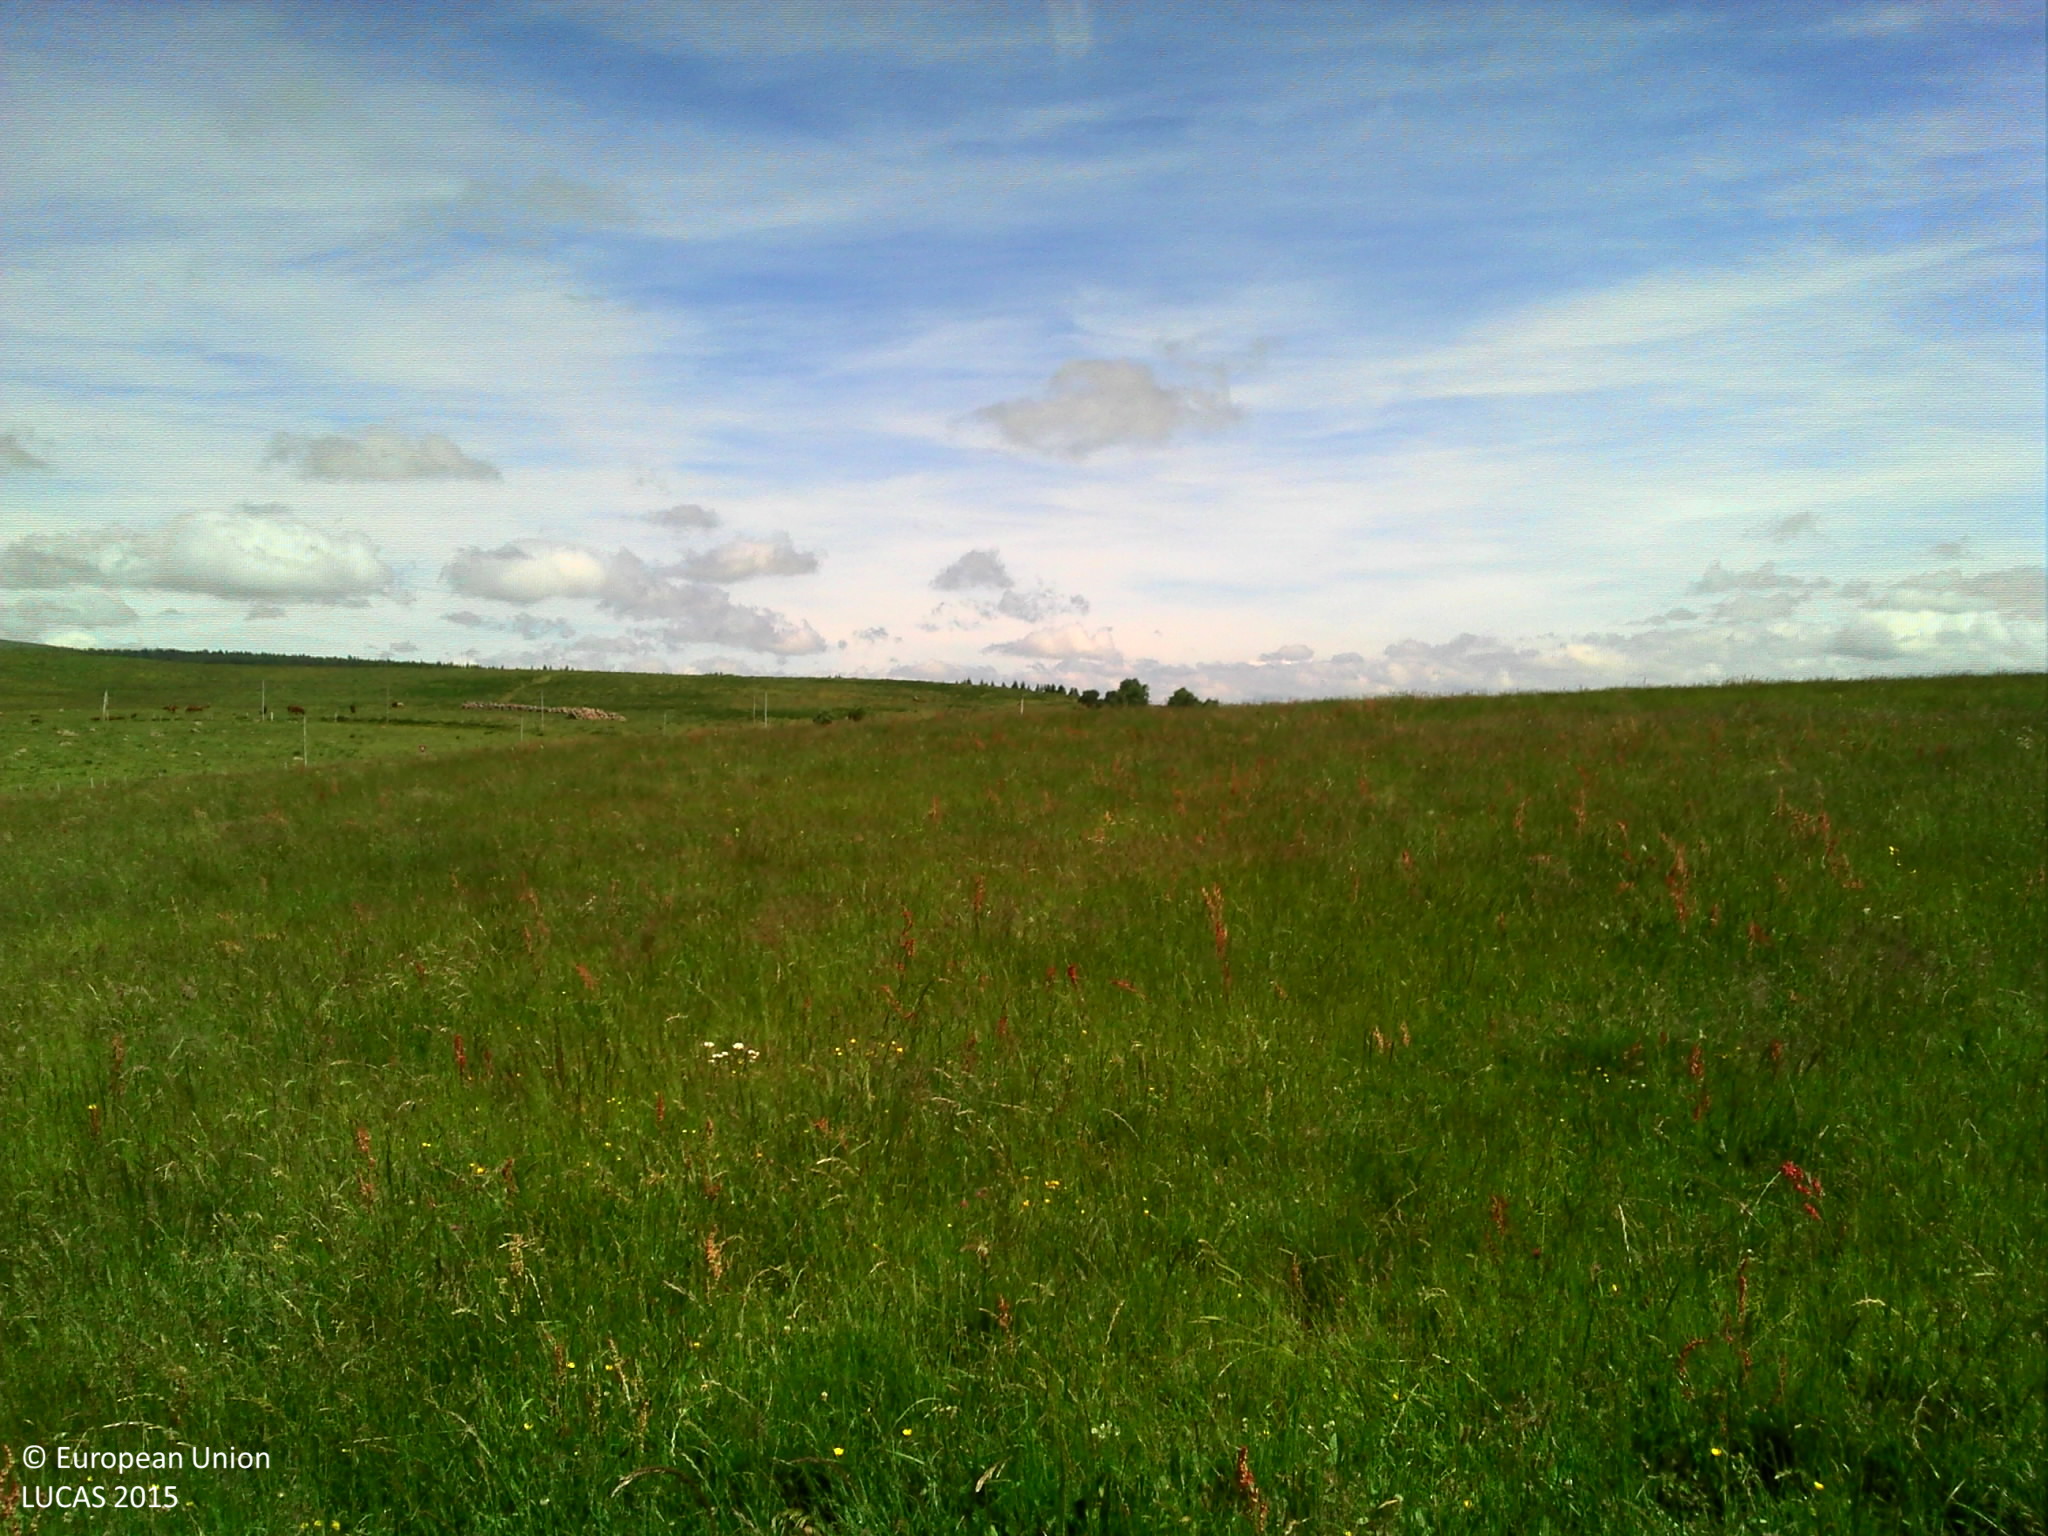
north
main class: Grassland
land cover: Grassland without tree/shrub cover
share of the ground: > 75 %
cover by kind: herbaceous plants 100 %
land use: Agriculture (excluding fallow land and kitchen gardens)
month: June
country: FR
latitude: 45.0109
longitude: 2.8836
